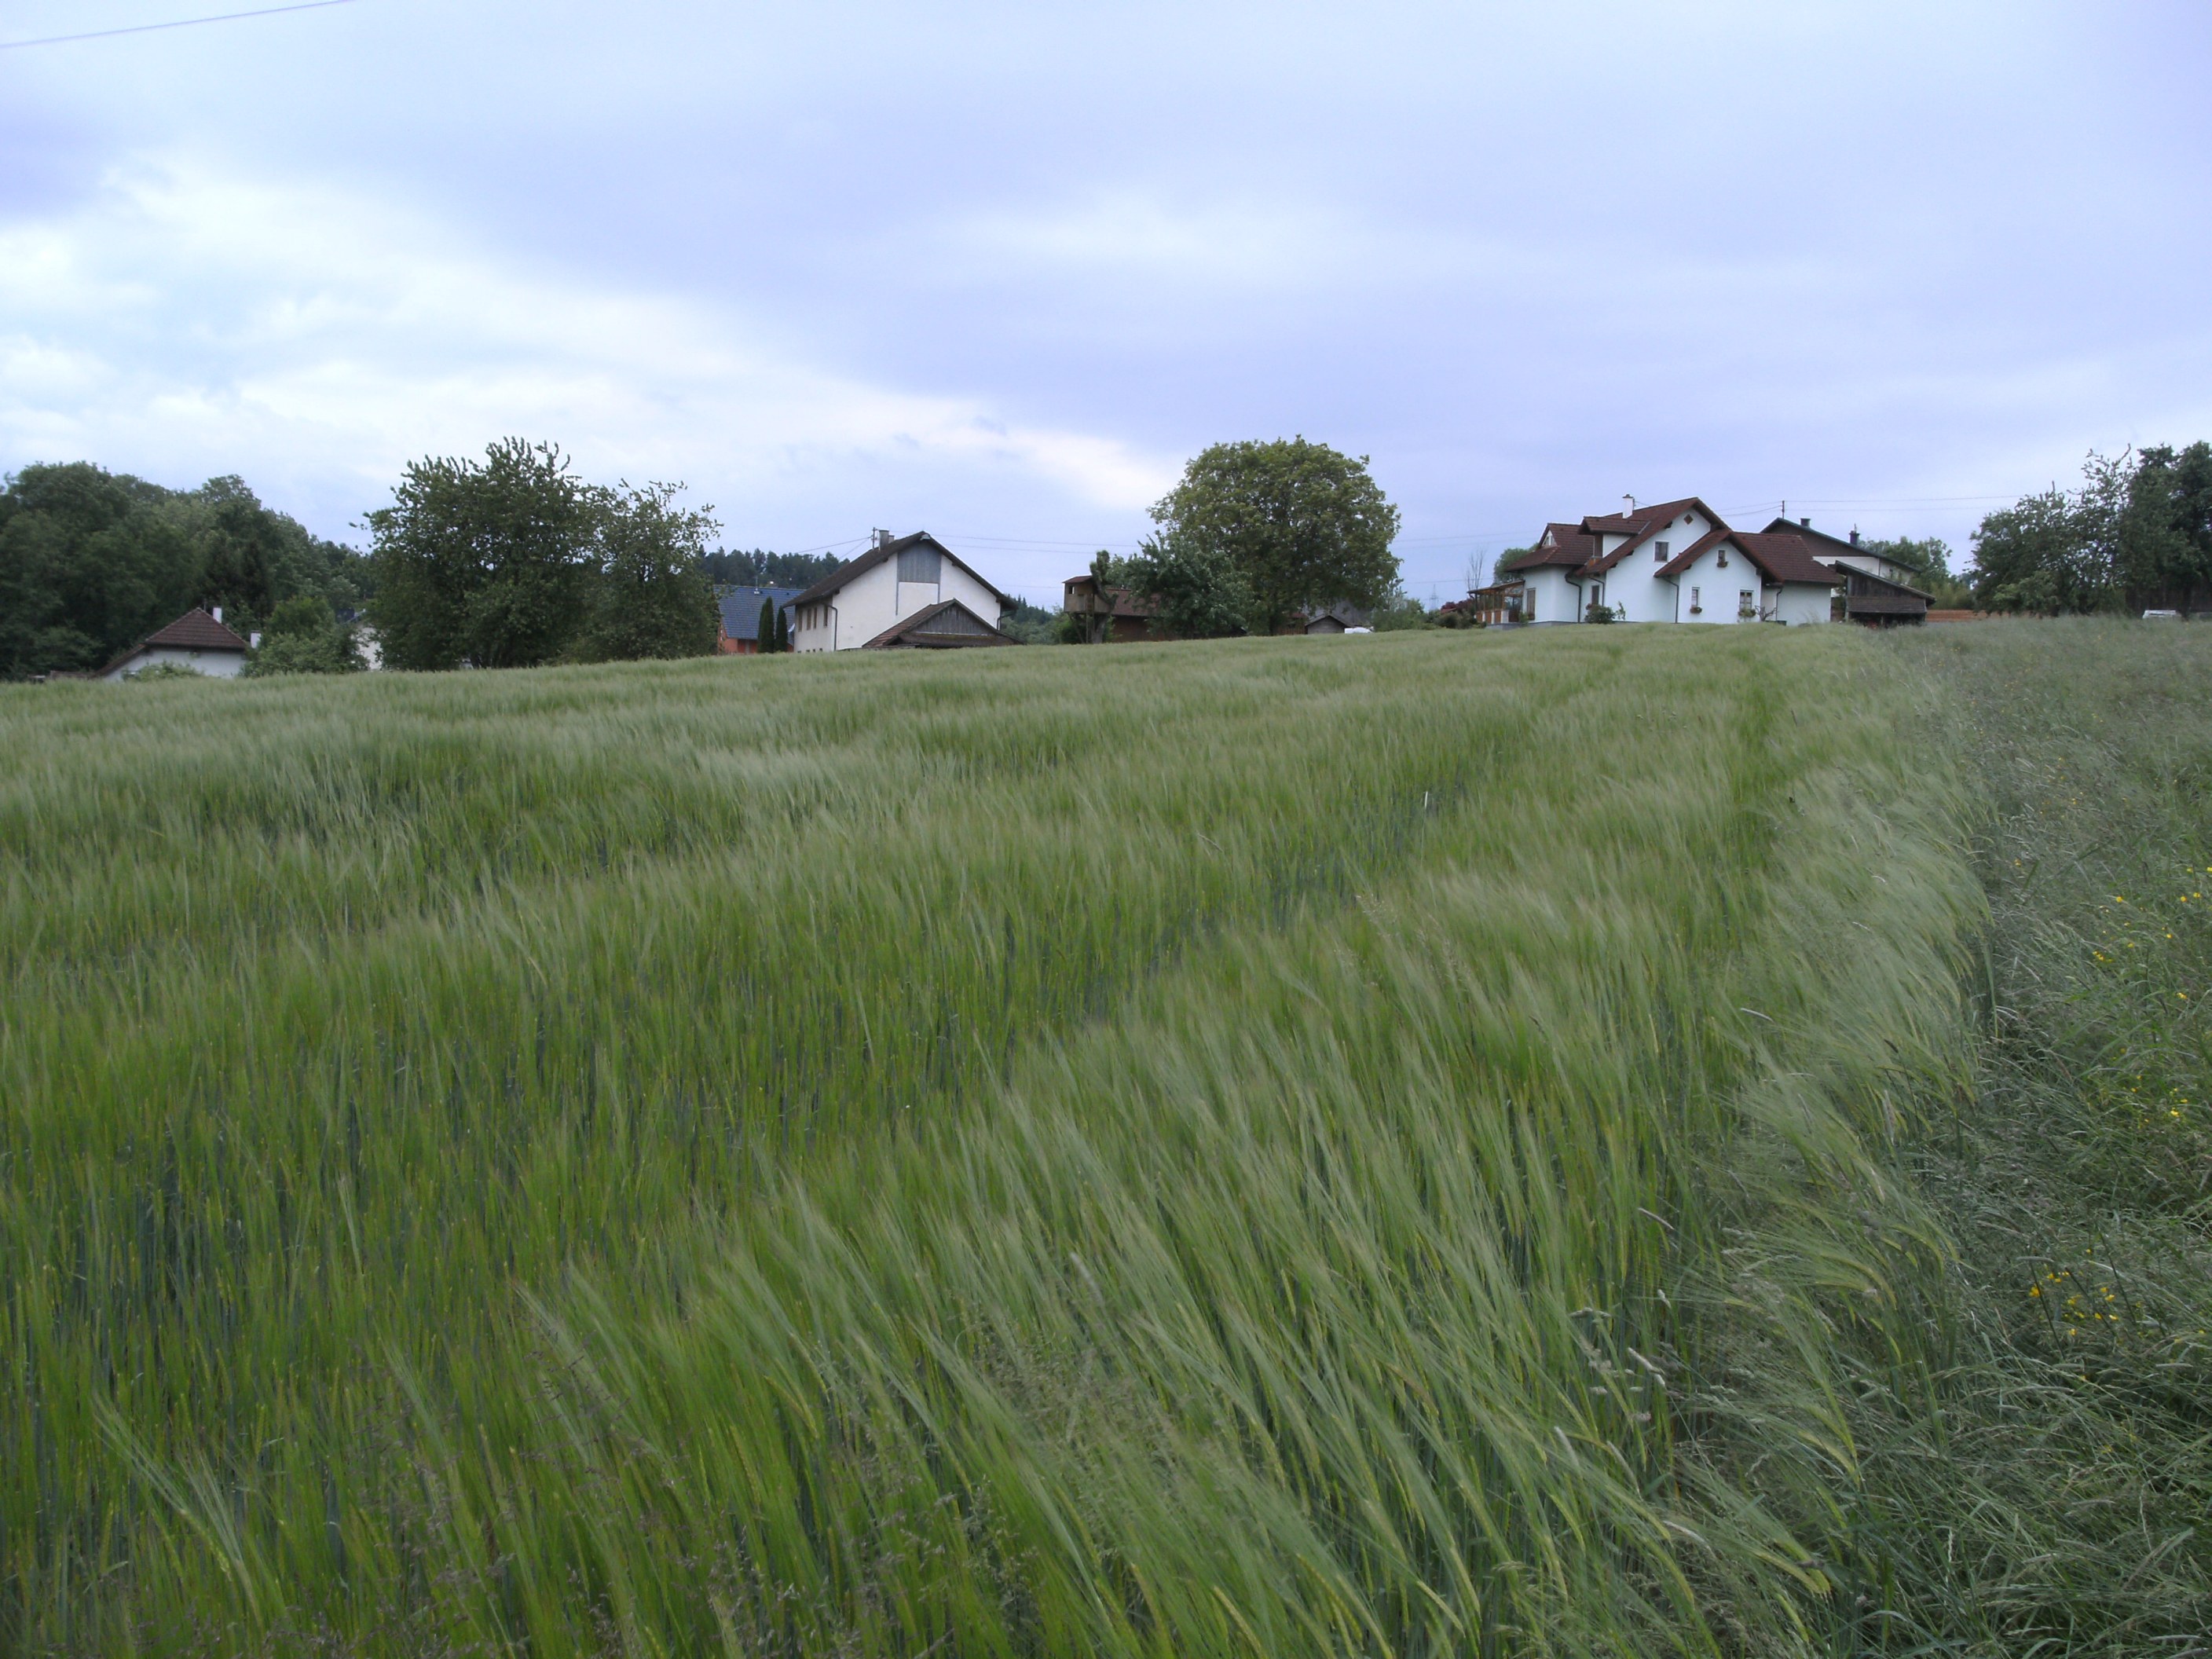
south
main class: Cropland
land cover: Barley
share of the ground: > 75 %
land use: Agriculture (excluding fallow land and kitchen gardens)
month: May
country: AT
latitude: 48.2370
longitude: 13.5943
